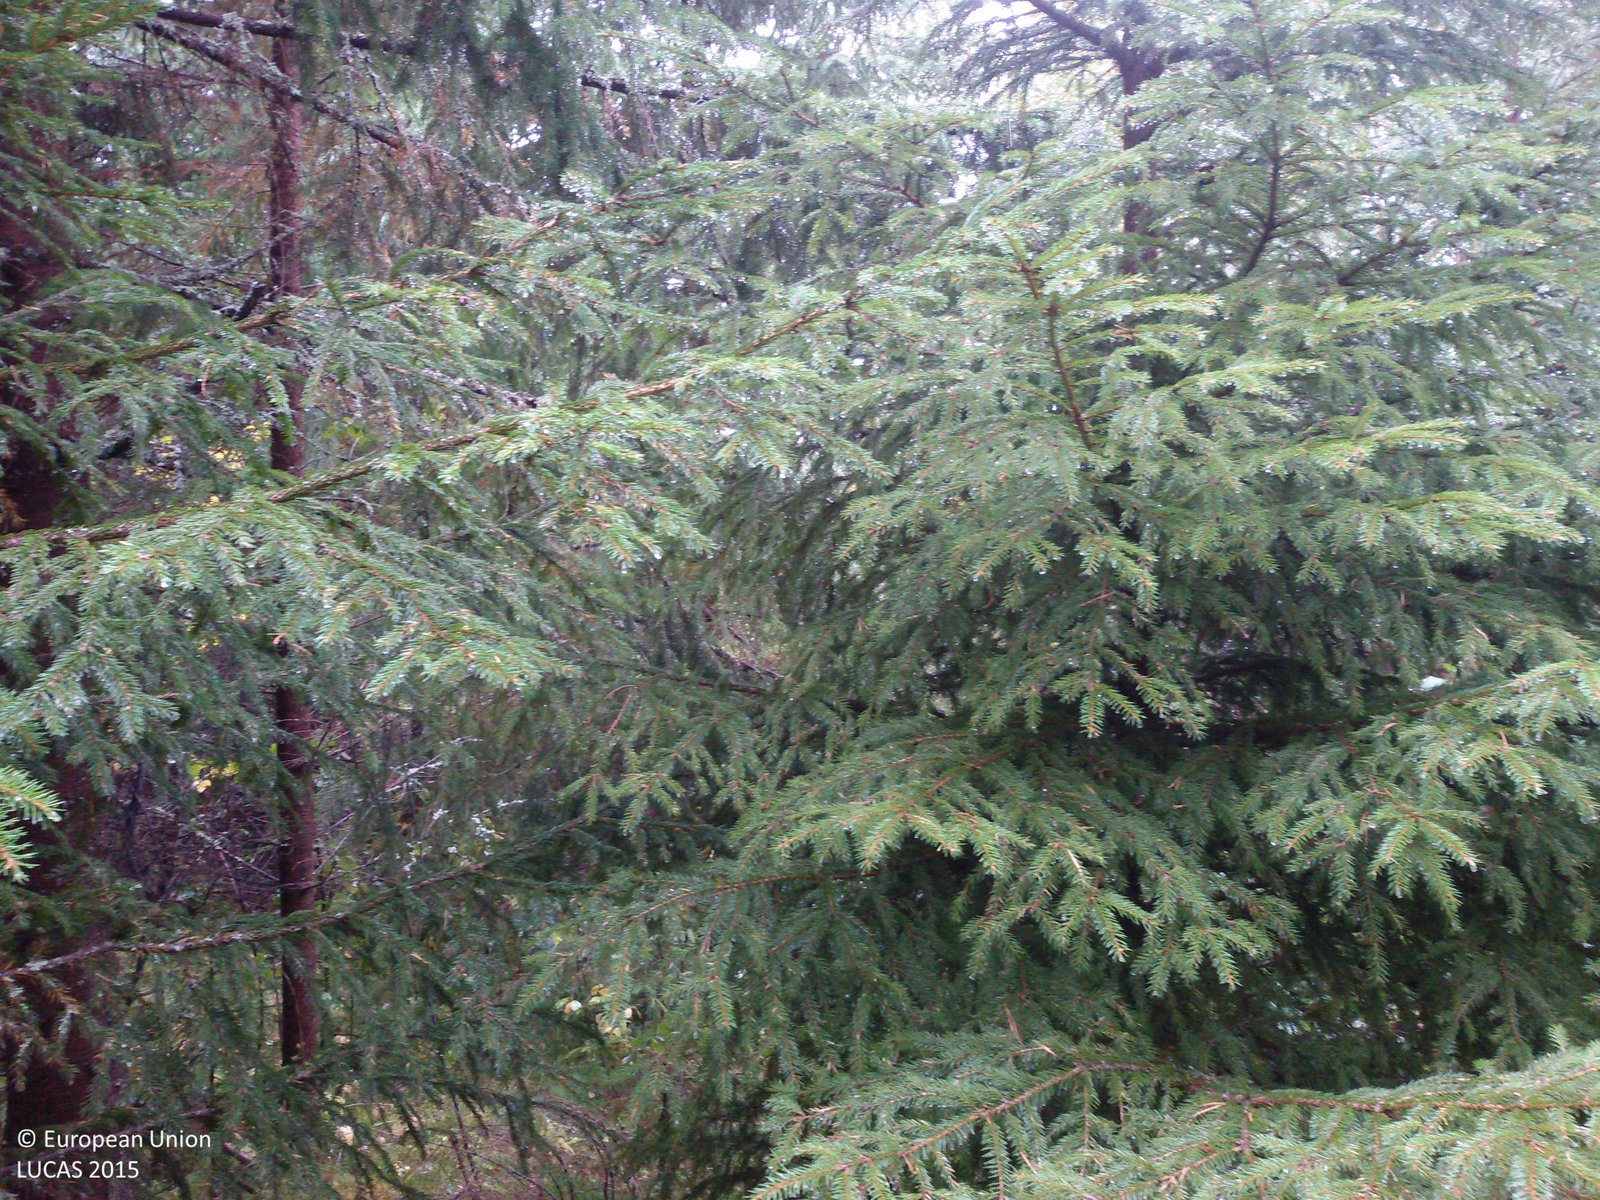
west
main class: Woodland
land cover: Spruce dominated mixed woodland
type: boreal forest
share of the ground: 50 - 75 %
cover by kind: coniferous forest trees 40 %, broadleaved forest trees 30 %, herbaceous plants 20 %, shrubs 10 %
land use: Amenities, museums, leisure
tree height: > 5 m
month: September
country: SE
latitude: 60.8822
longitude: 14.5742
